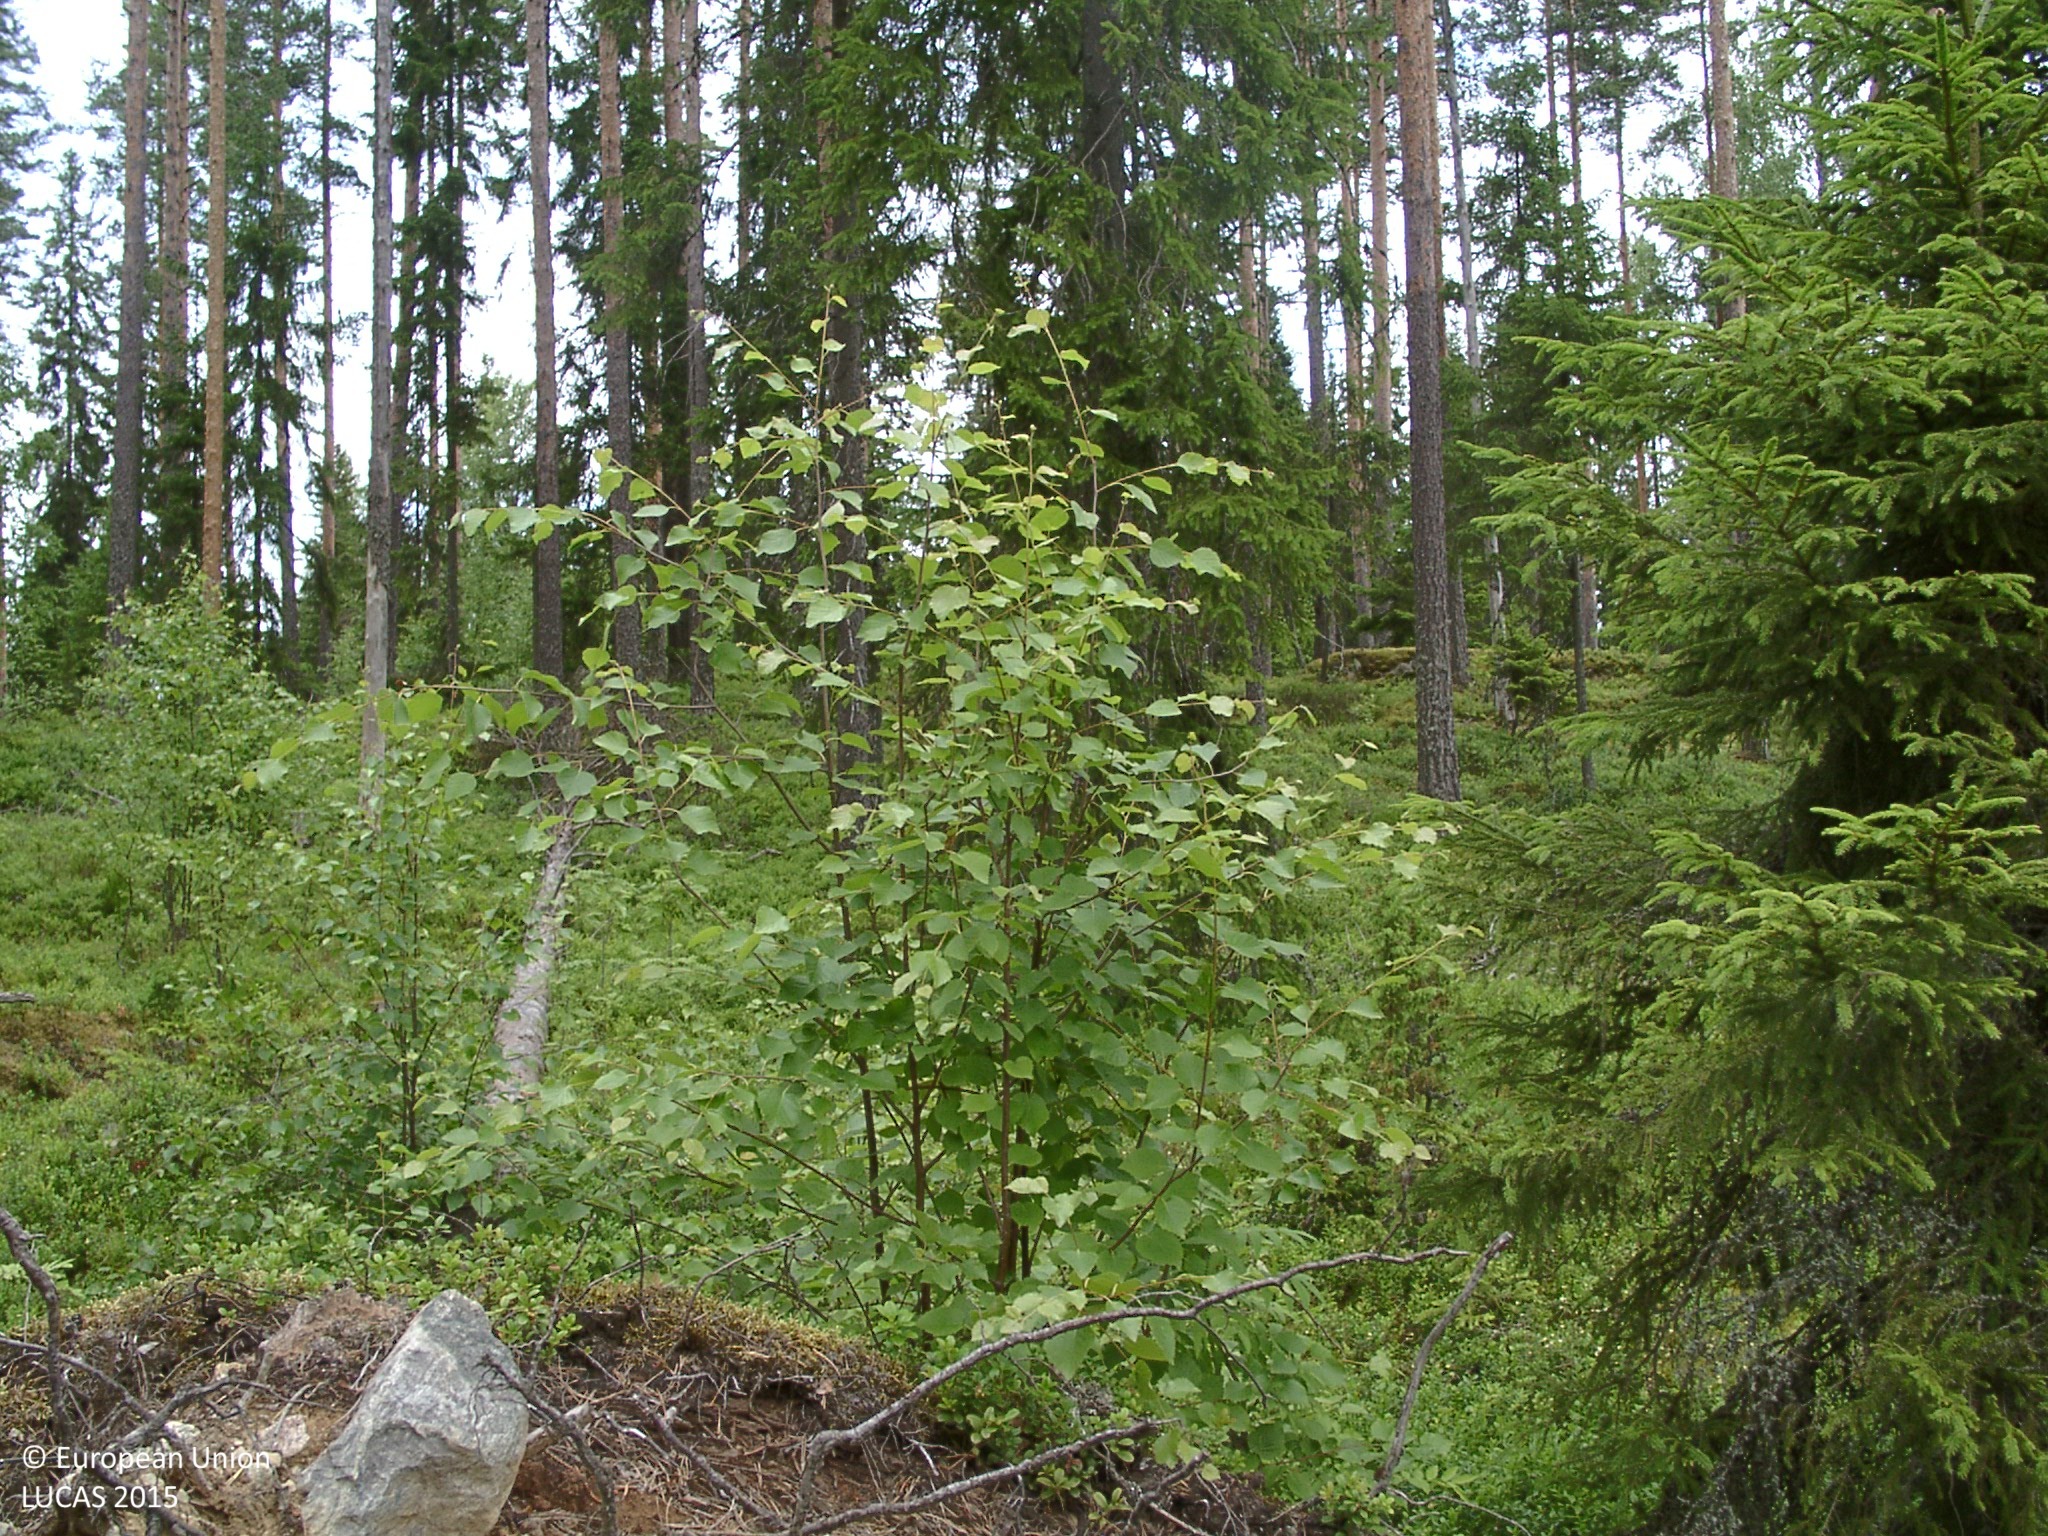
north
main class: Woodland
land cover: Other mixed woodland
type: boreal forest
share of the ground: 50 - 75 %
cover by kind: shrubs 40 %, coniferous forest trees 35 %, broadleaved forest trees 15 %, lichens and mosses 10 %
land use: Forestry
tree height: > 5 m
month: July
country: FI
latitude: 61.7027
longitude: 25.2217
